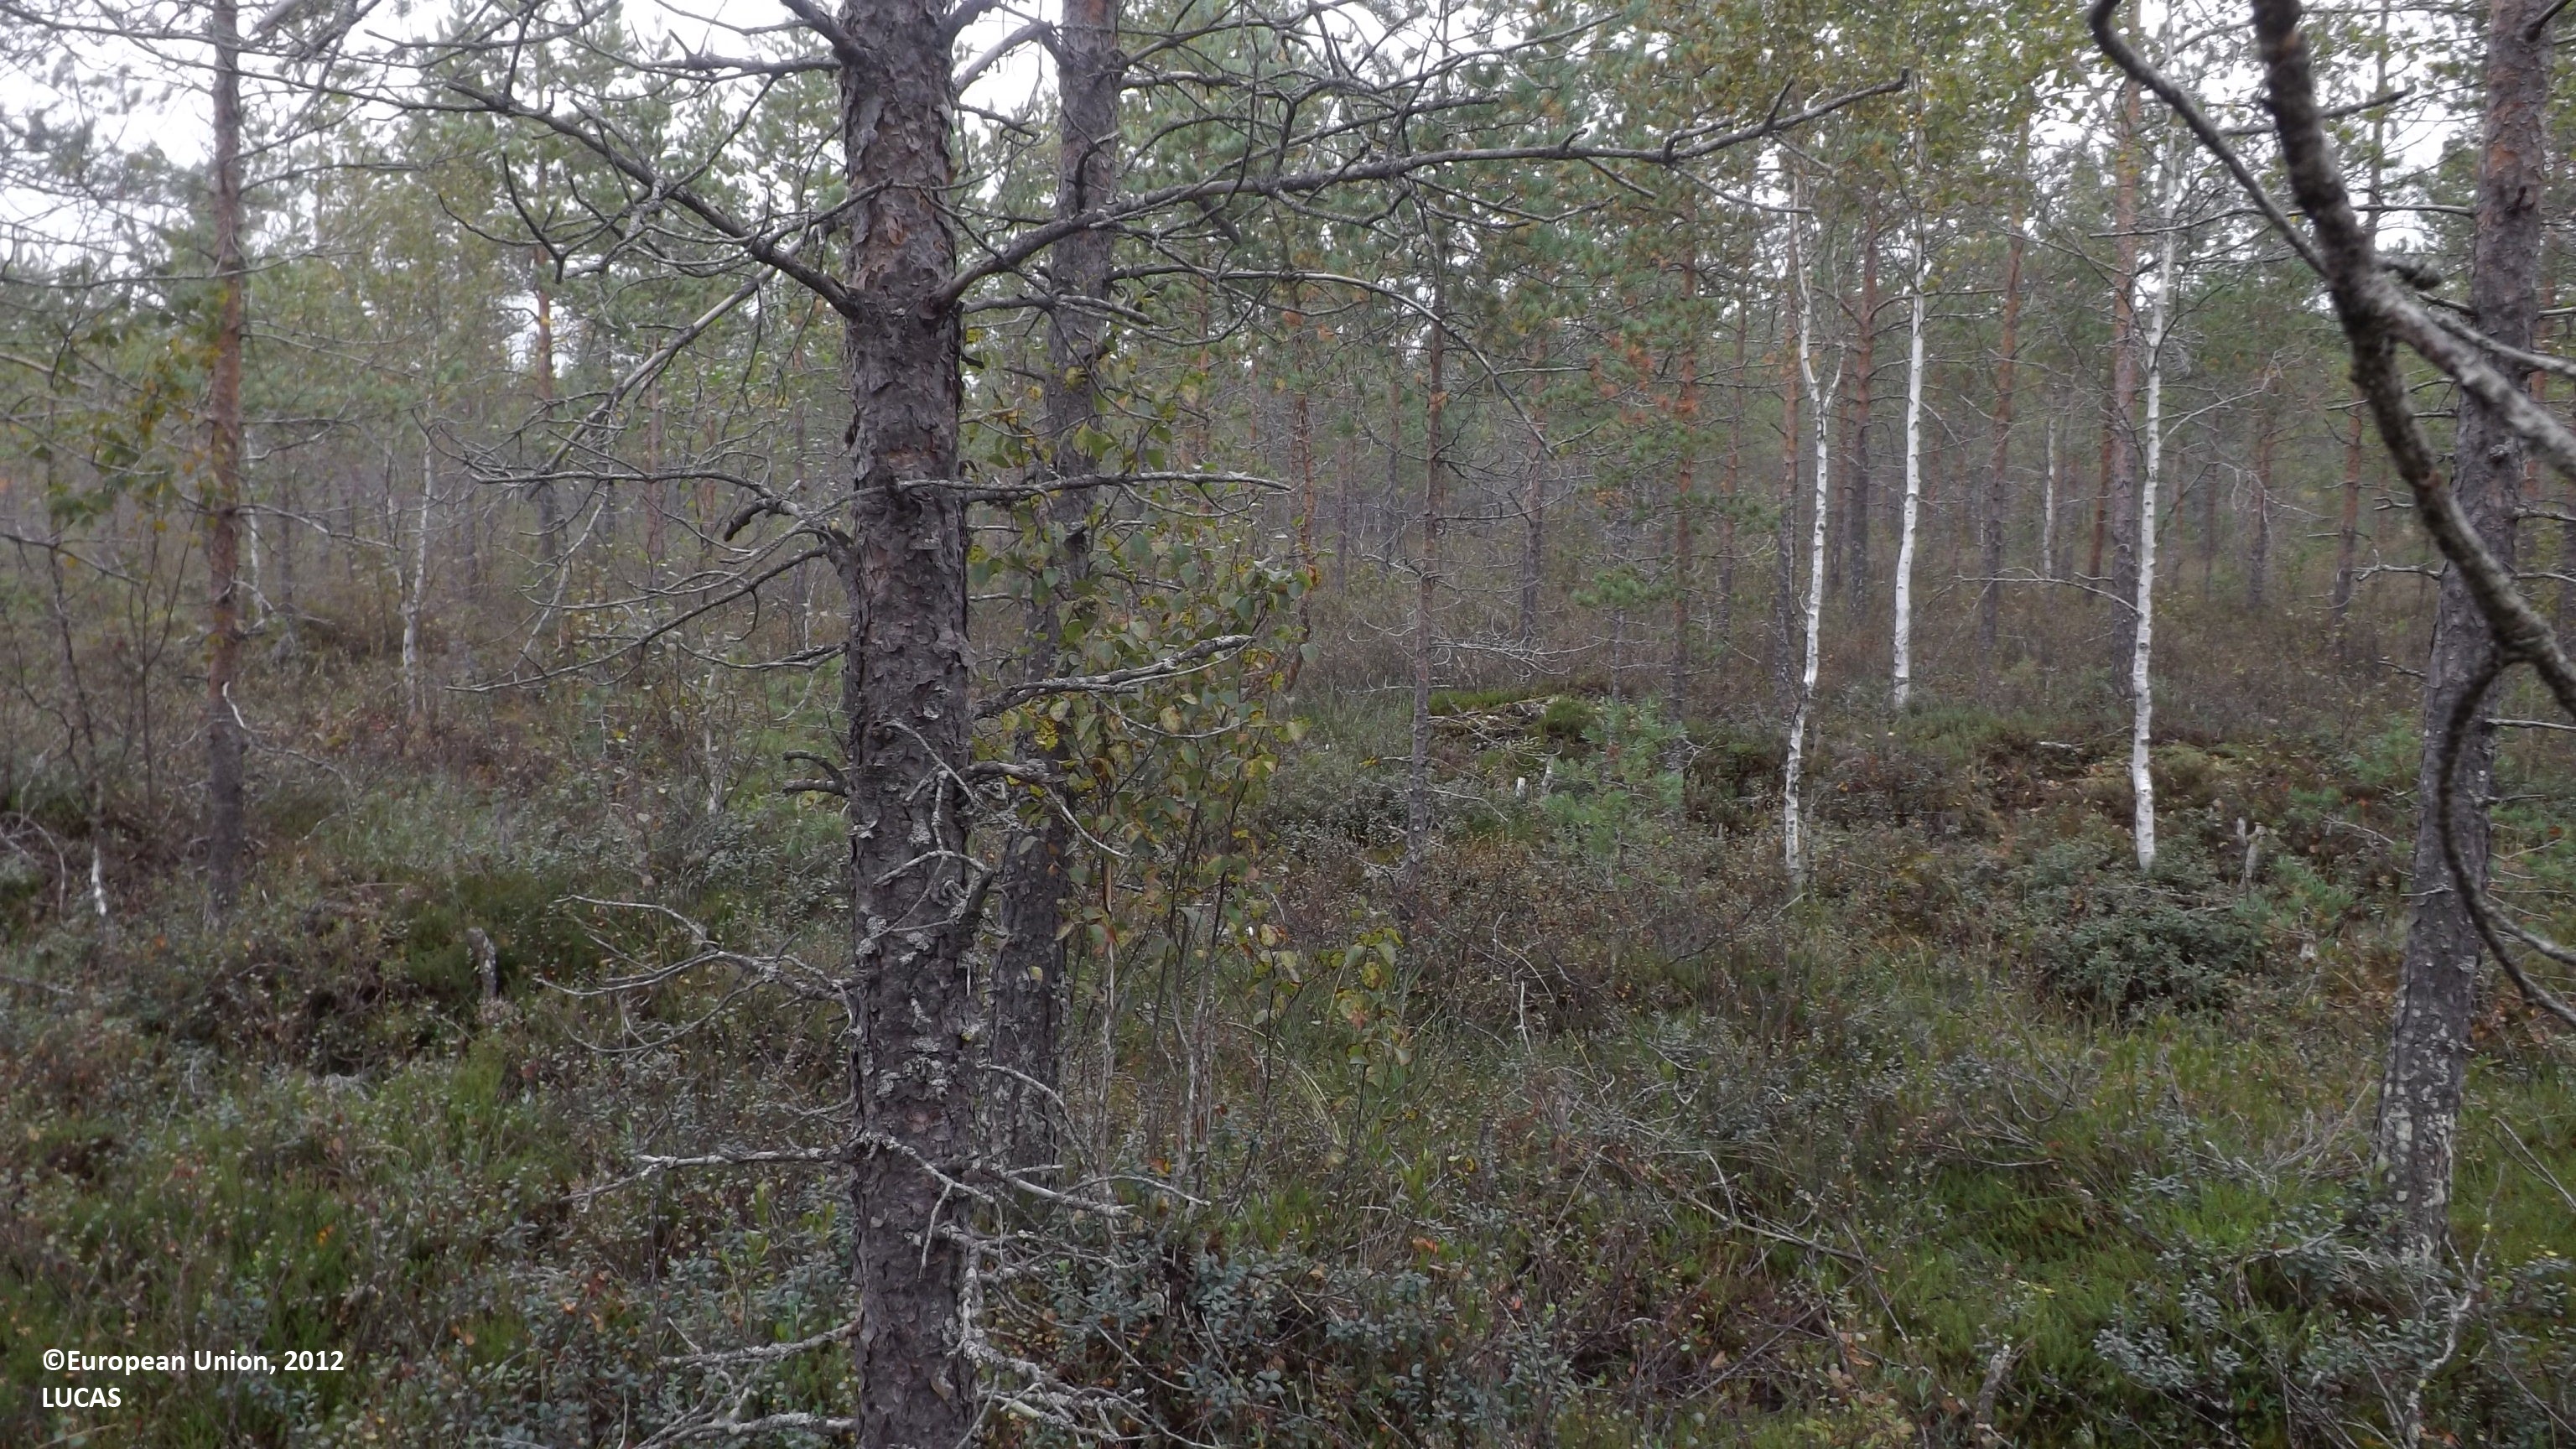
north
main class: Woodland
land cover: Pine dominated coniferous woodland
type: mire and swamp forests
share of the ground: 50 - 75 %
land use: Forestry
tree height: > 5 m
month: August
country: FI
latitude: 63.9251
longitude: 23.9518
